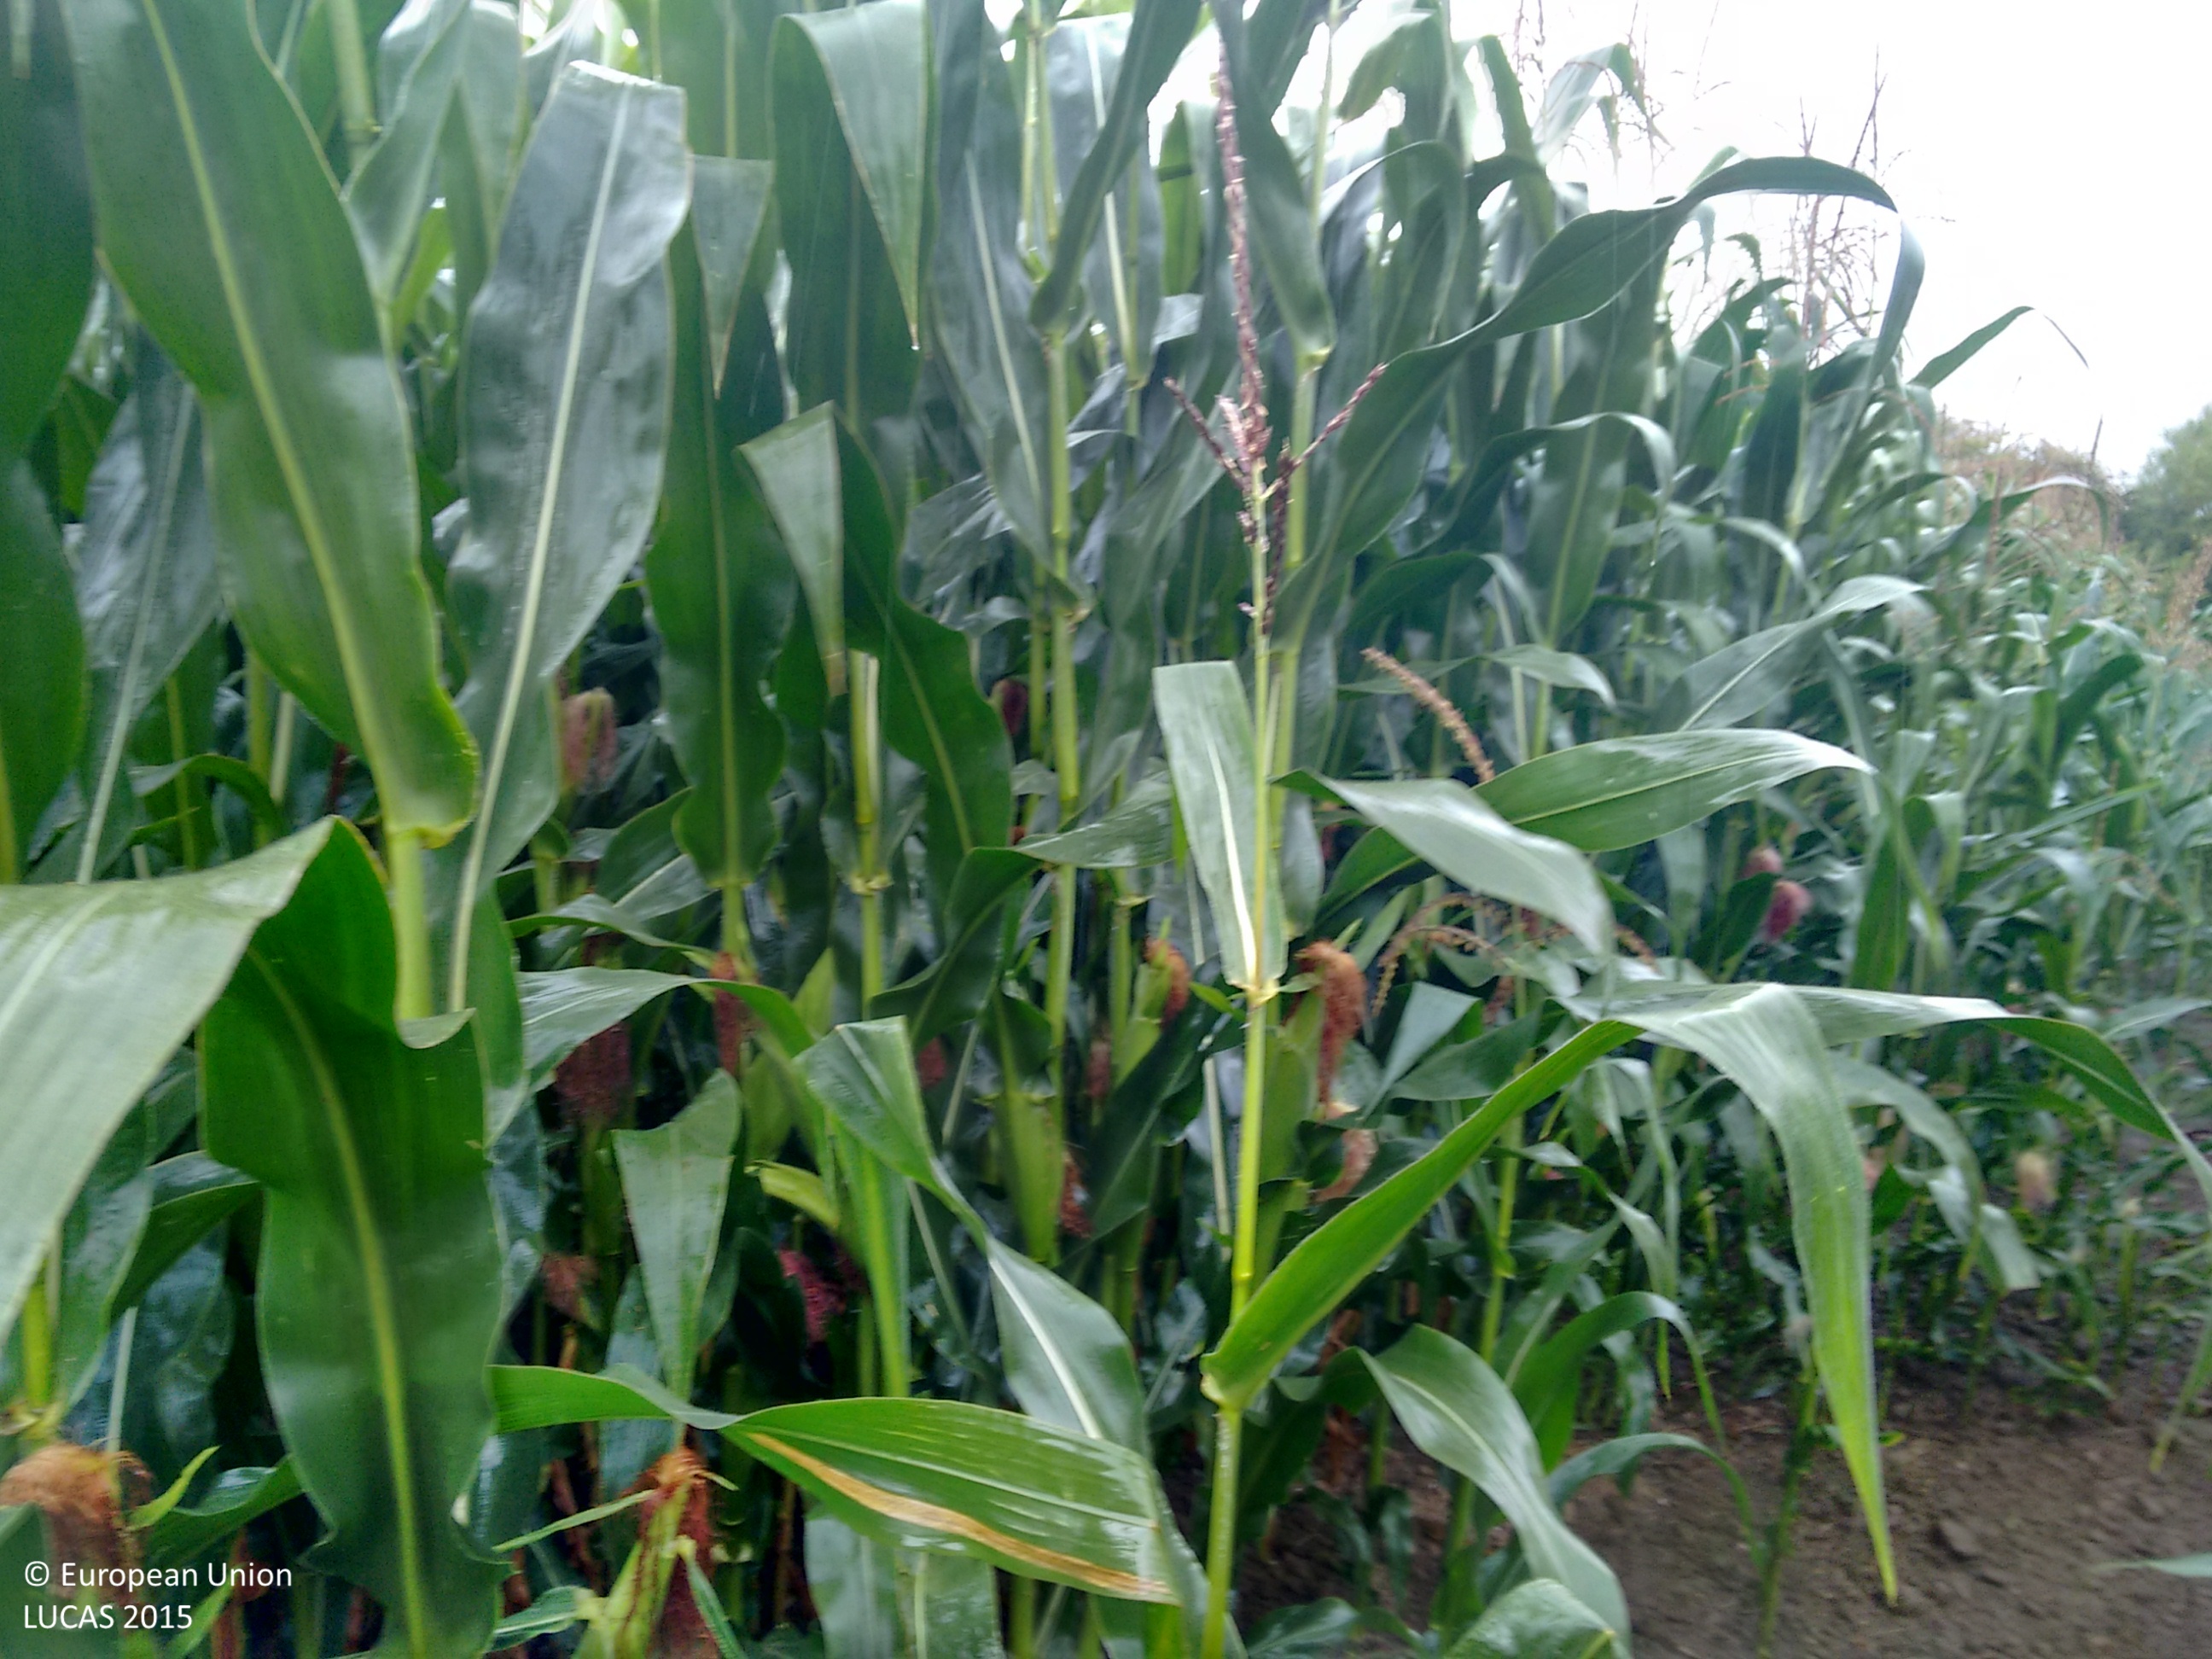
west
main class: Cropland
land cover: Maize
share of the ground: > 75 %
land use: Agriculture (excluding fallow land and kitchen gardens)
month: September
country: GB
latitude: 53.1022
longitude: -2.9636
